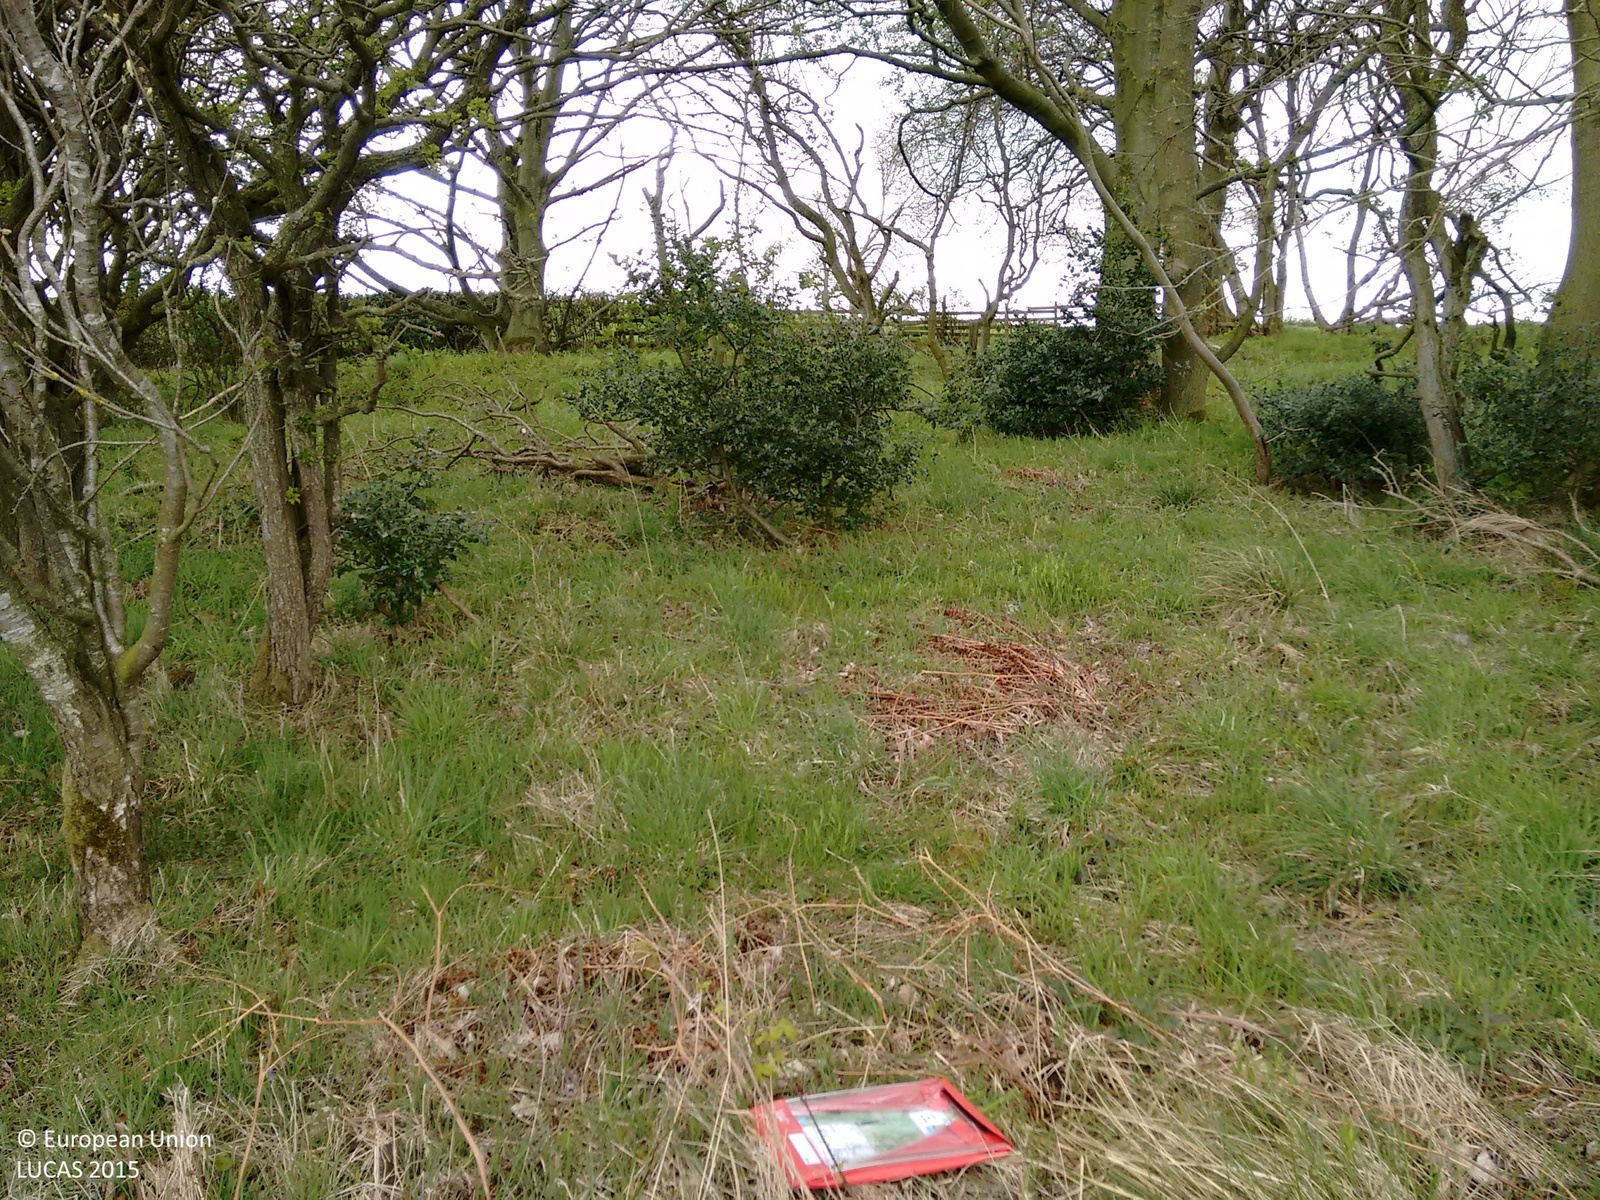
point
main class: Woodland
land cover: Broadleaved woodland
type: acidophilous oak and oak-birch forest
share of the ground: > 75 %
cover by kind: broadleaved forest trees 100 %
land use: Semi-natural and natural areas not in use
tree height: > 5 m
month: May
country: GB
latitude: 54.9077
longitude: -2.0498
